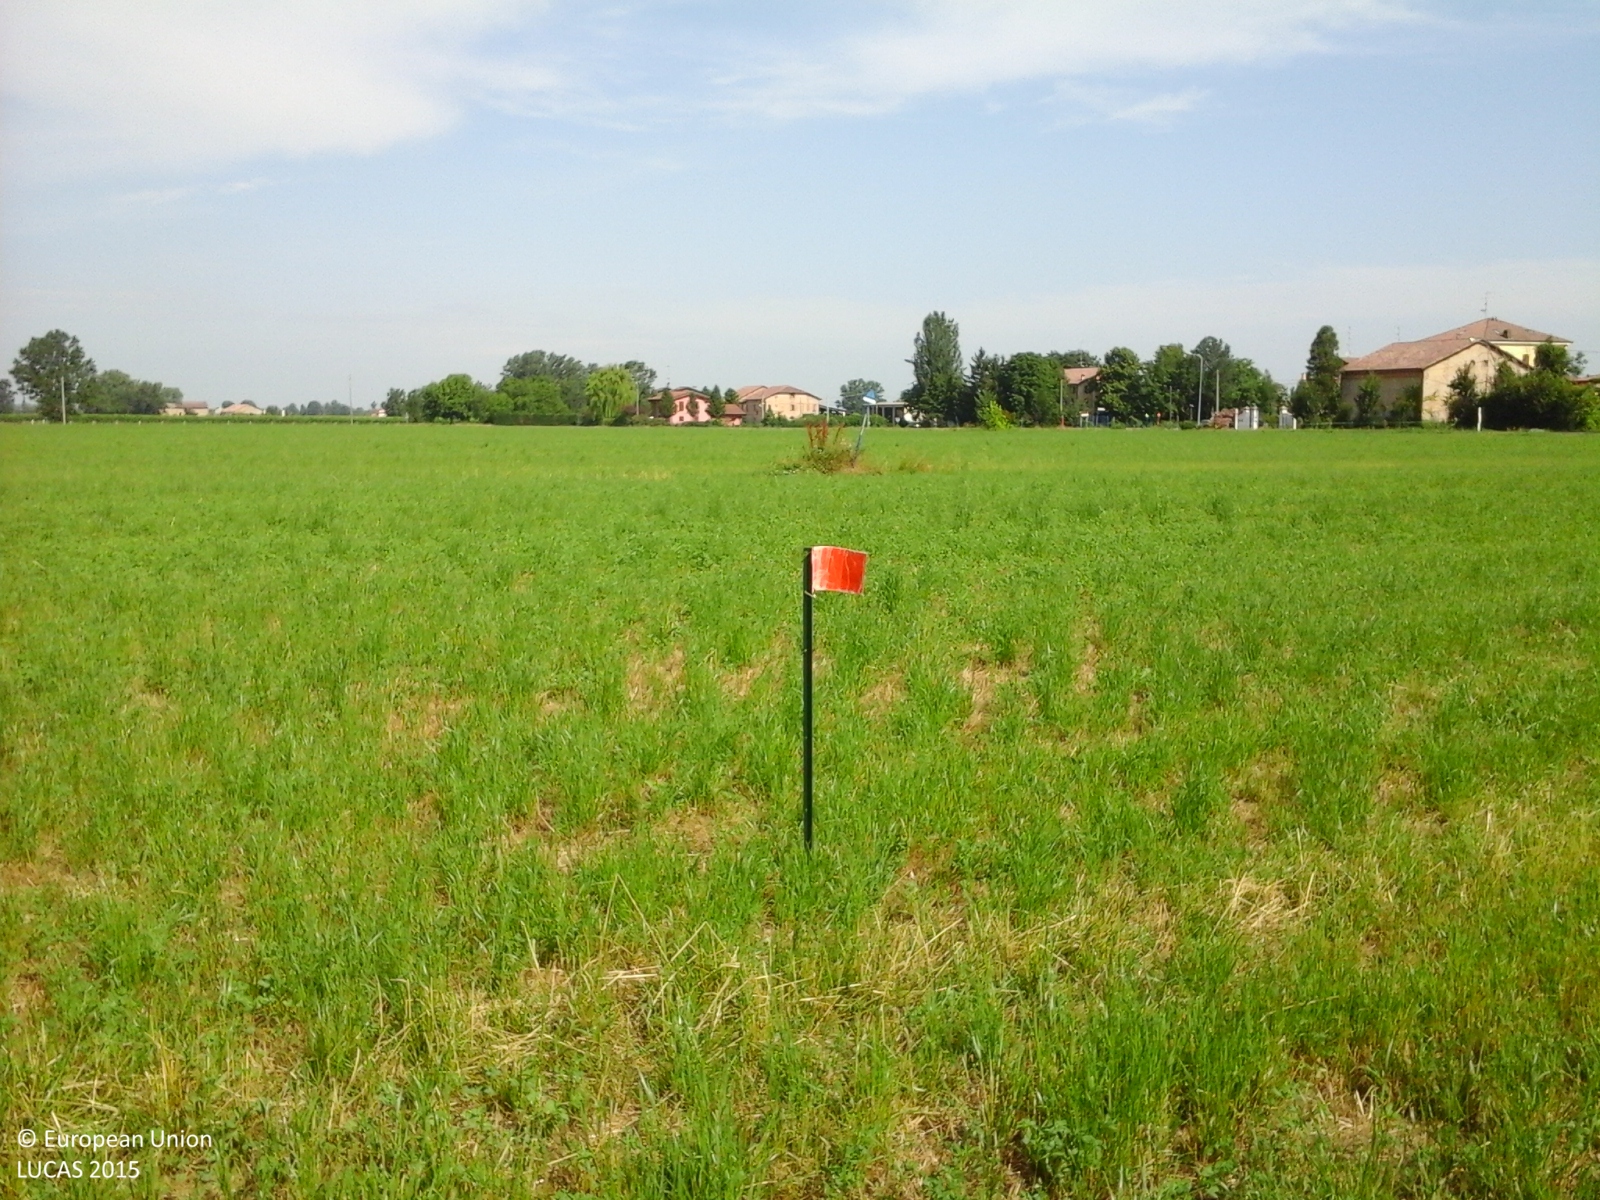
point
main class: Grassland
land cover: Spontaneously vegetated surfaces
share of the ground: > 75 %
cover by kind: herbaceous plants 100 %
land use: Agriculture (excluding fallow land and kitchen gardens)
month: June
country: IT
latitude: 44.7270
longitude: 10.6930
